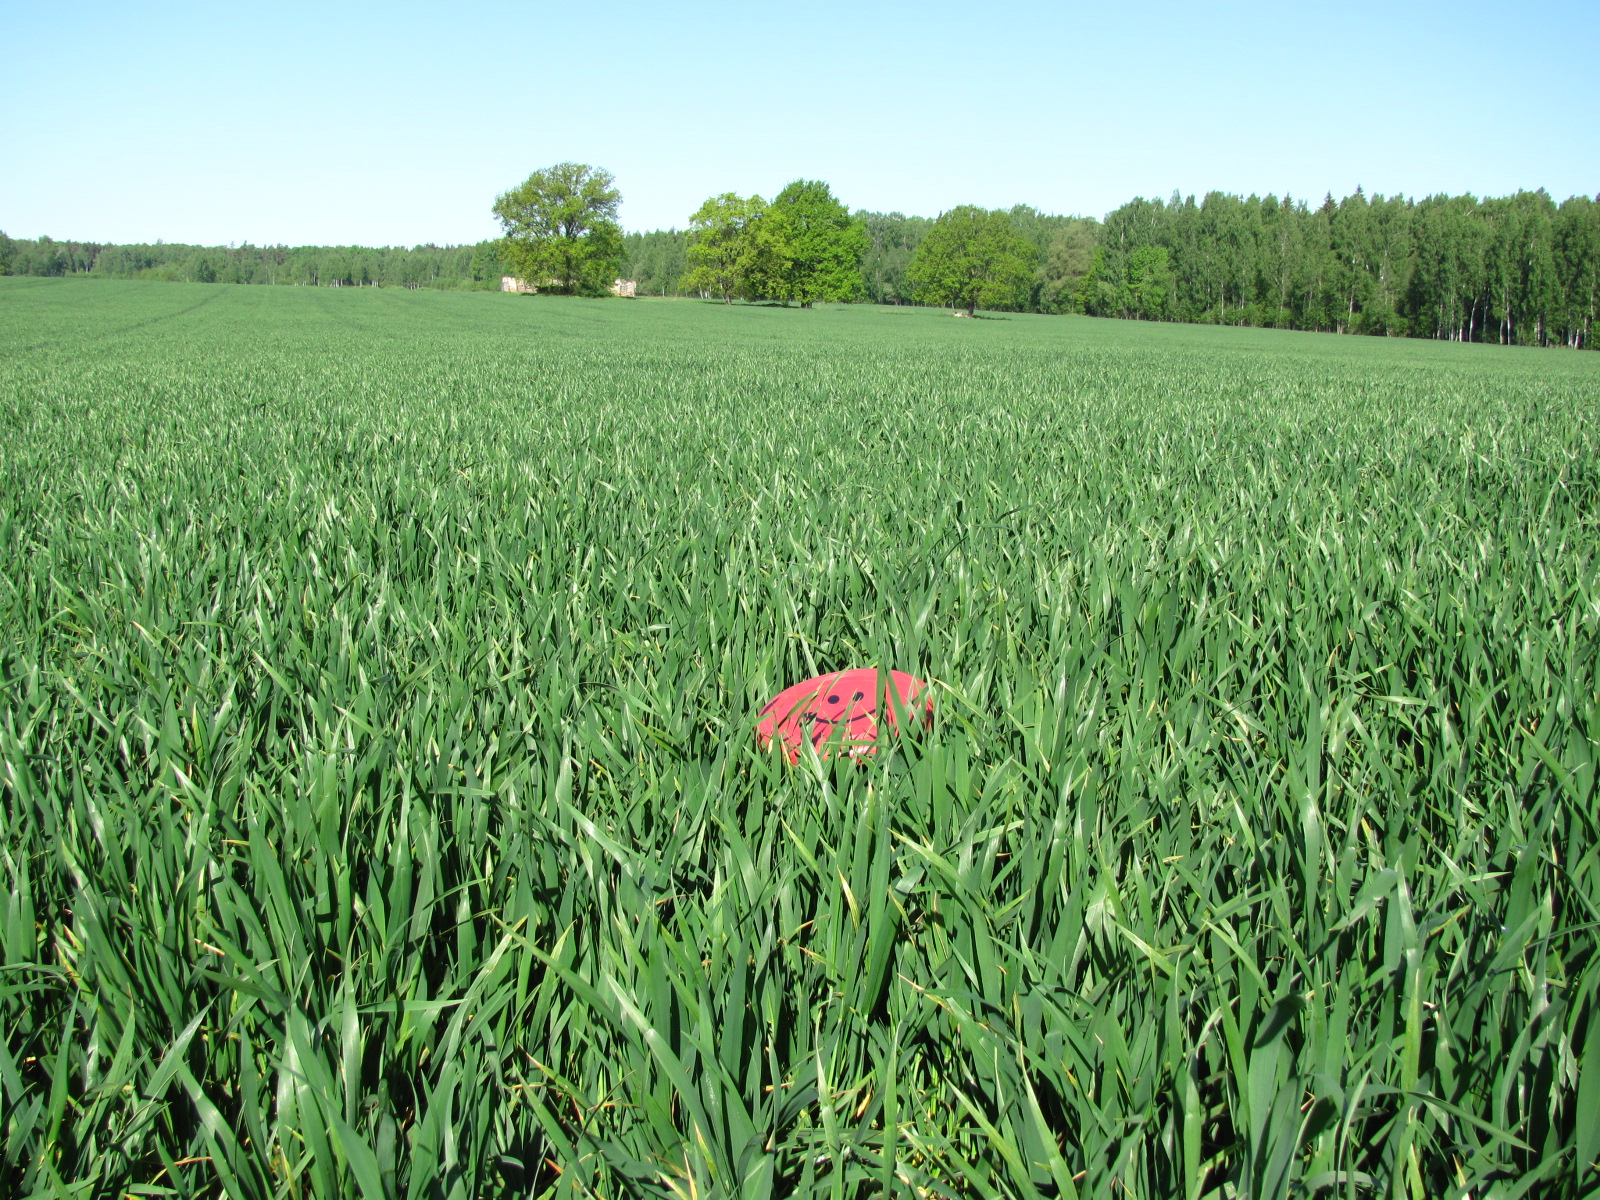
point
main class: Cropland
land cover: Common wheat
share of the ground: > 75 %
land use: Agriculture (excluding fallow land and kitchen gardens)
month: May
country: LV
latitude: 56.5741
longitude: 24.1015
